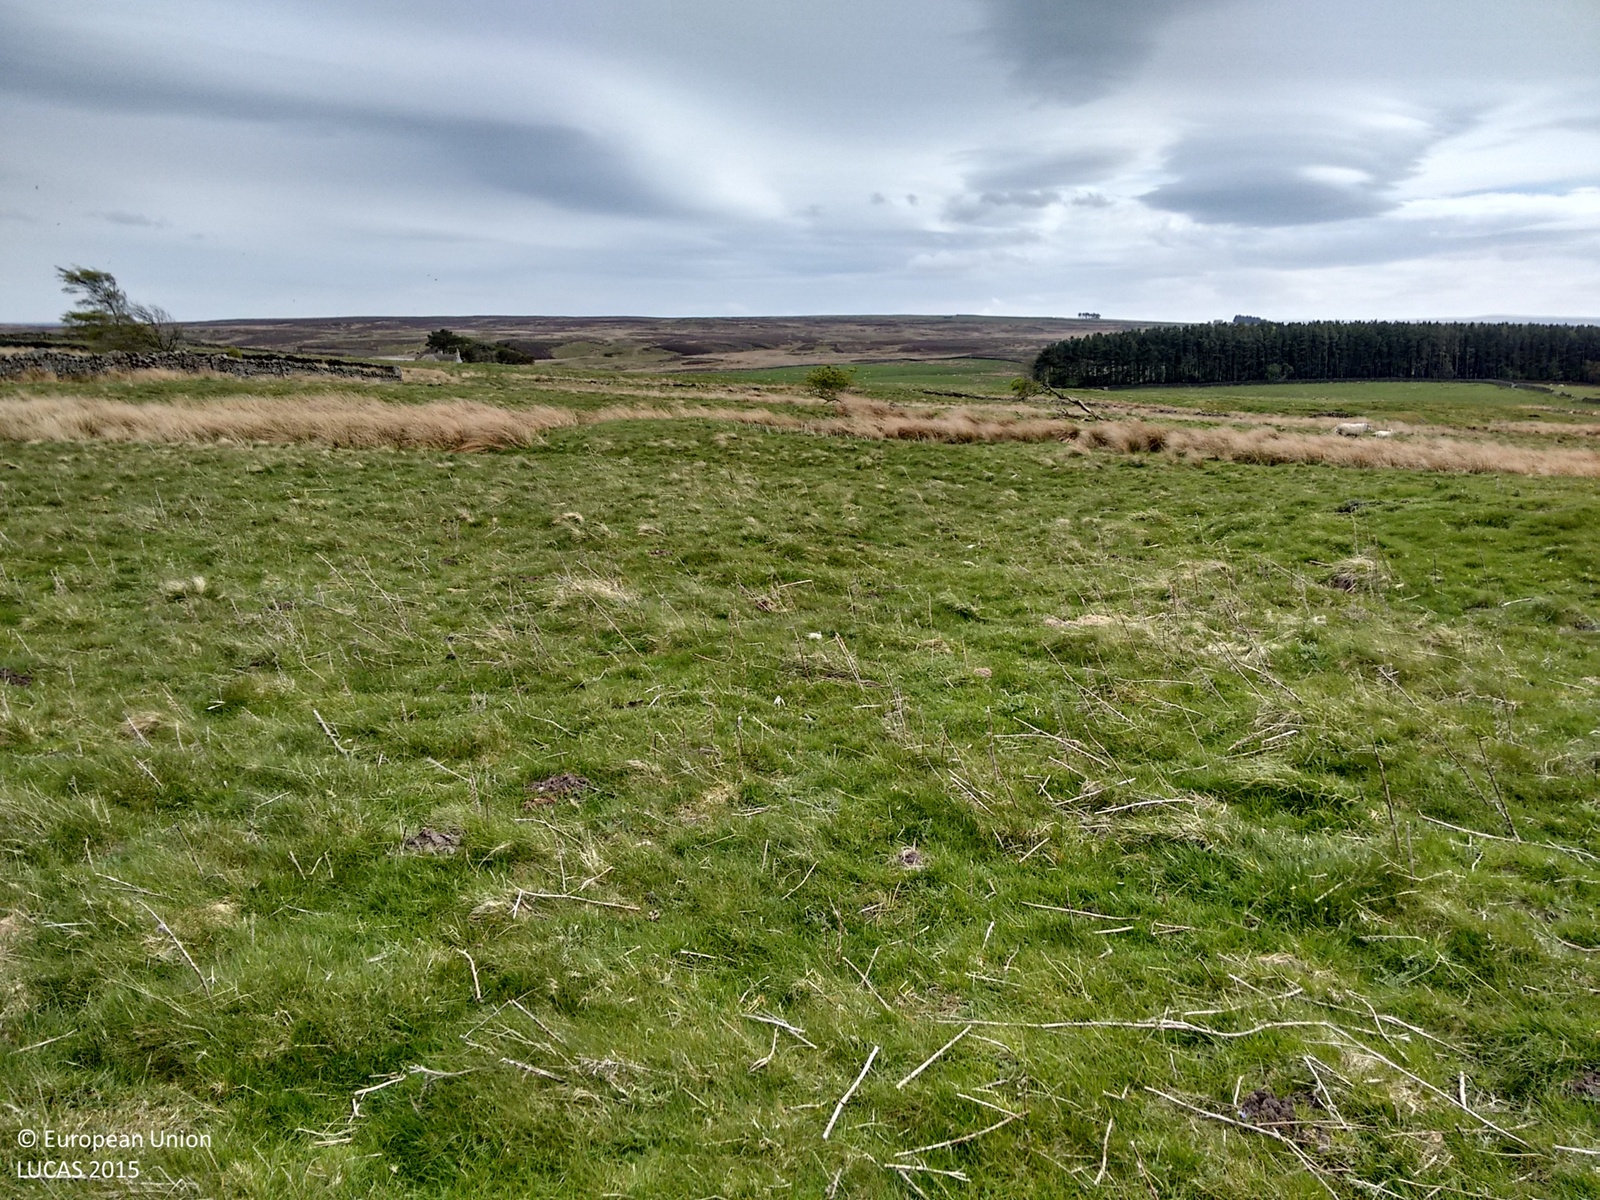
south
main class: Grassland
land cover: Grassland without tree/shrub cover
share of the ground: > 75 %
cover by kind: herbaceous plants 100 %
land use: Agriculture (excluding fallow land and kitchen gardens)
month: May
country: GB
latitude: 54.9427
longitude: -2.2506
